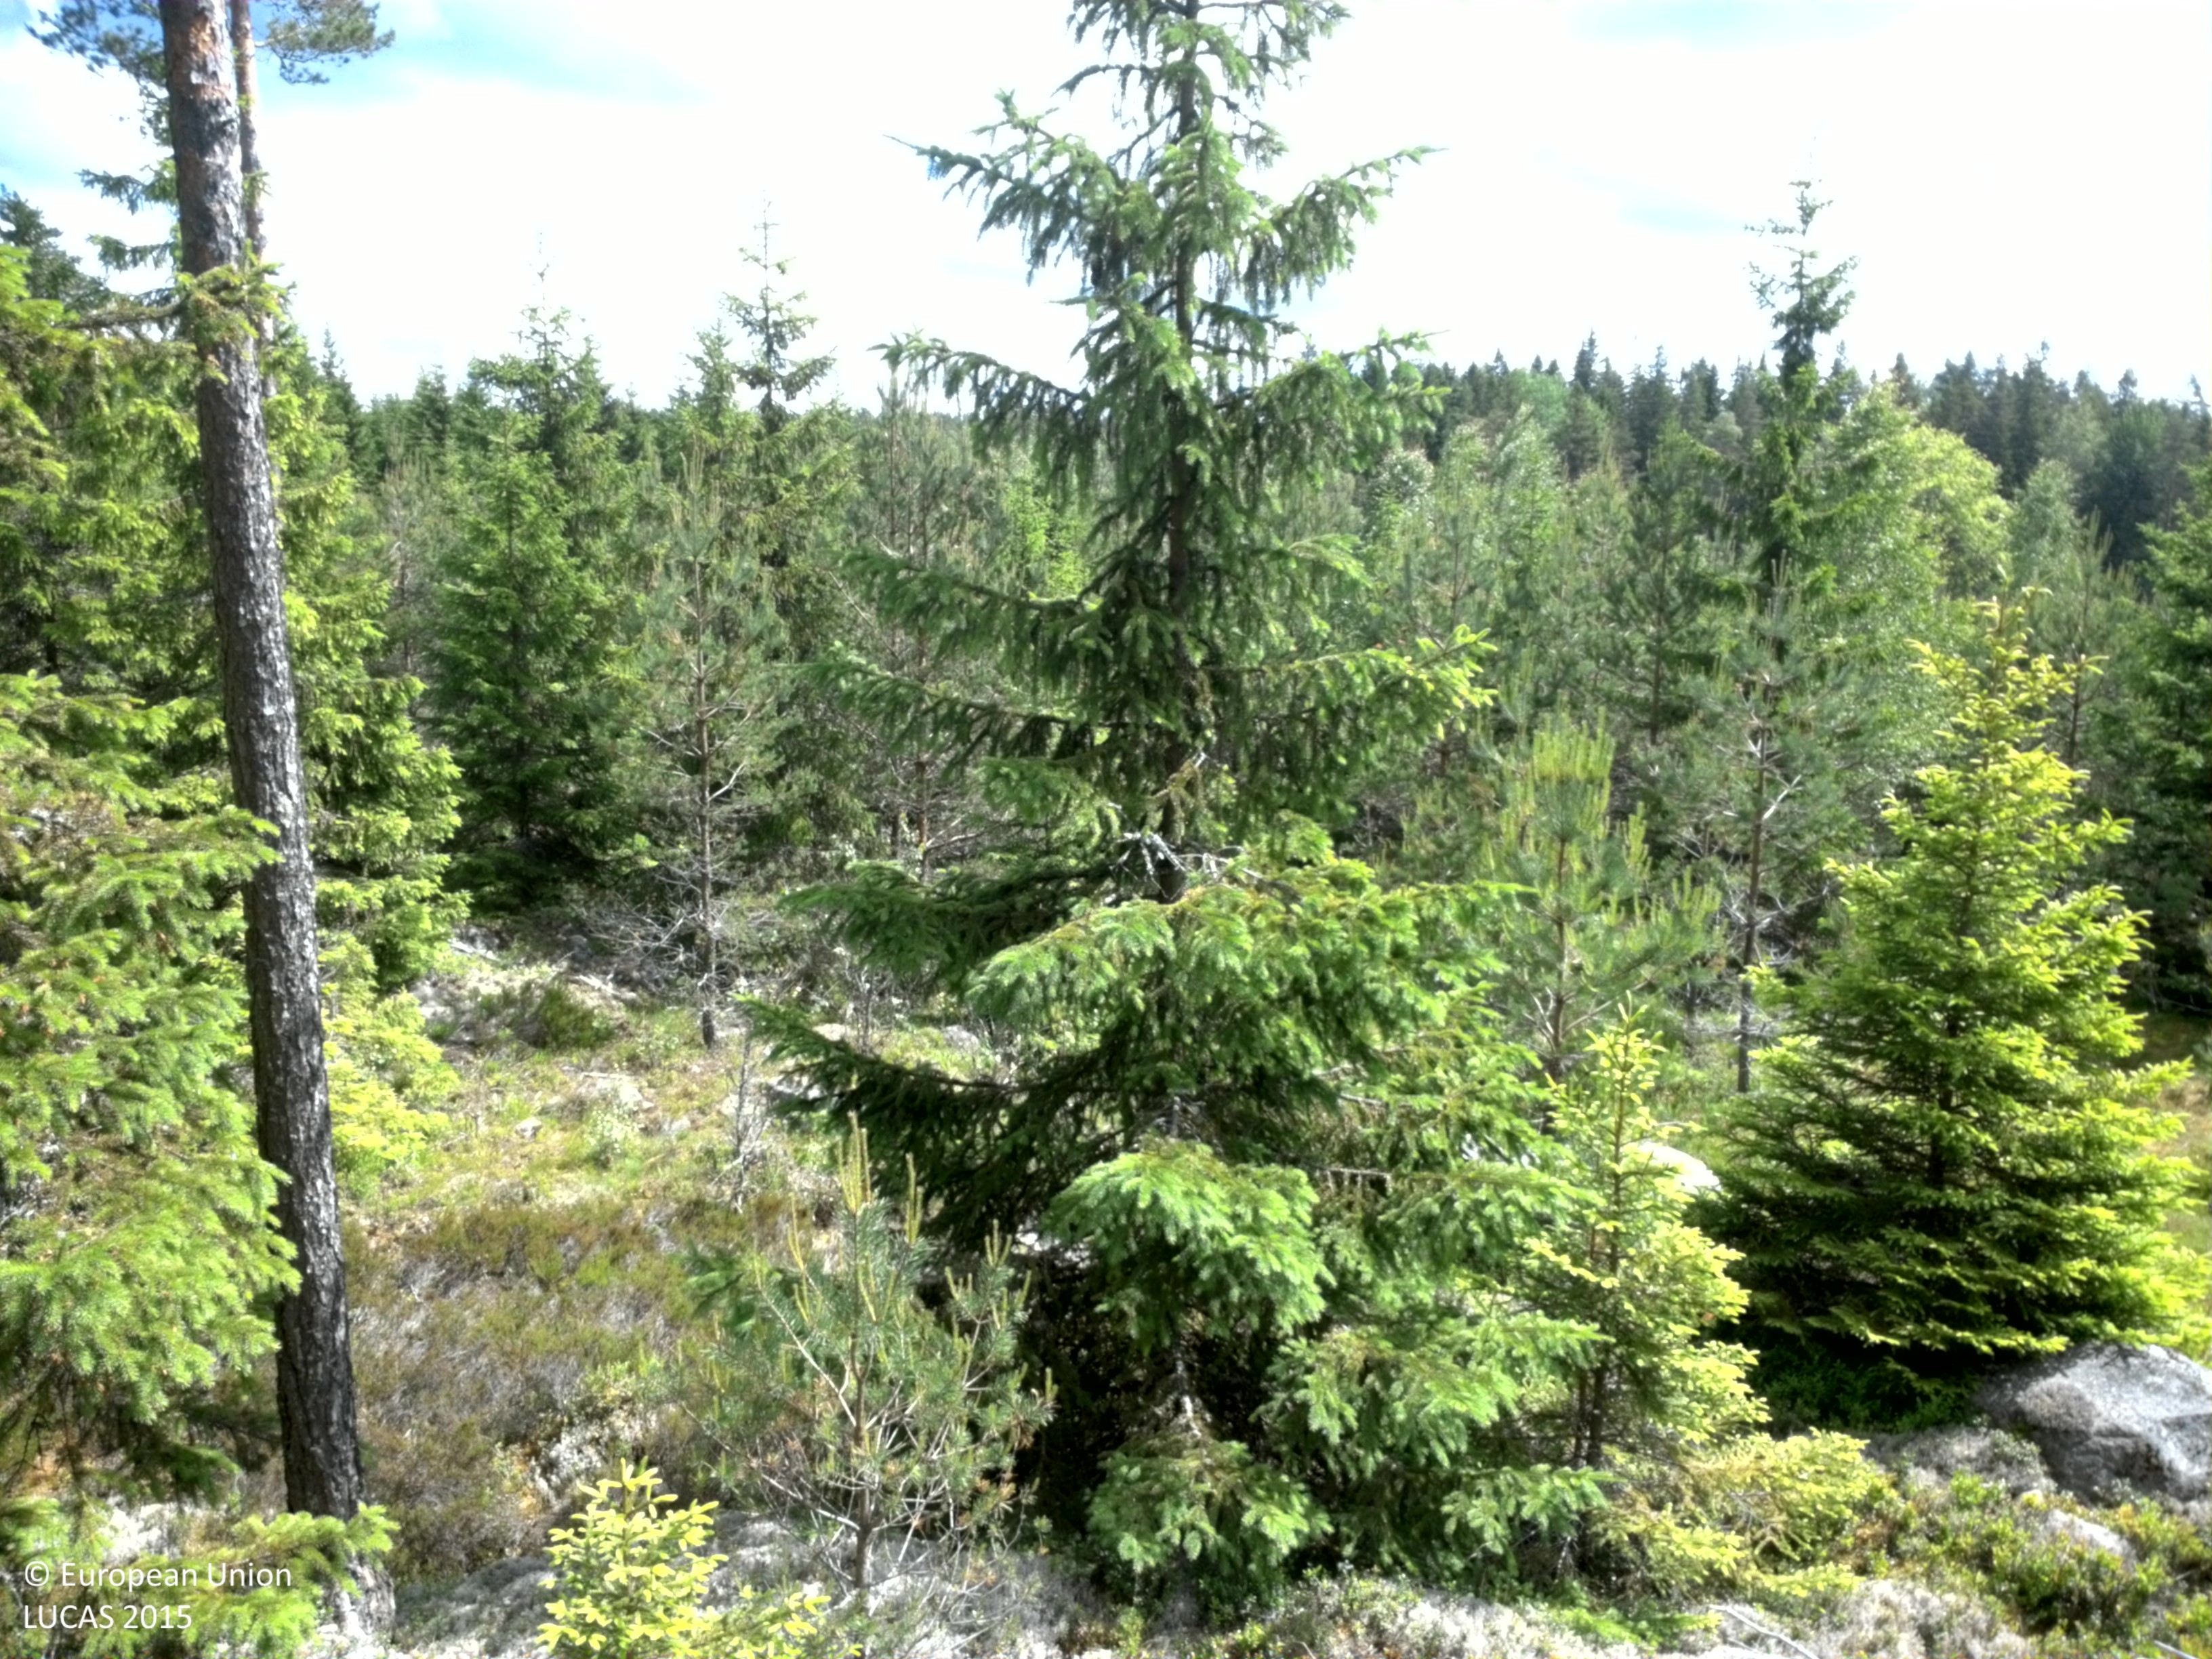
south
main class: Woodland
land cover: Pine dominated mixed woodland
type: boreal forest
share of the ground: 25 - 50 %
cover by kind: coniferous forest trees 30 %, herbaceous plants 30 %, lichens and mosses 25 %, broadleaved forest trees 10 %, consolidated bare surface 5 %
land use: Forestry
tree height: > 5 m
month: June
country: SE
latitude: 59.9655
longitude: 17.1030
